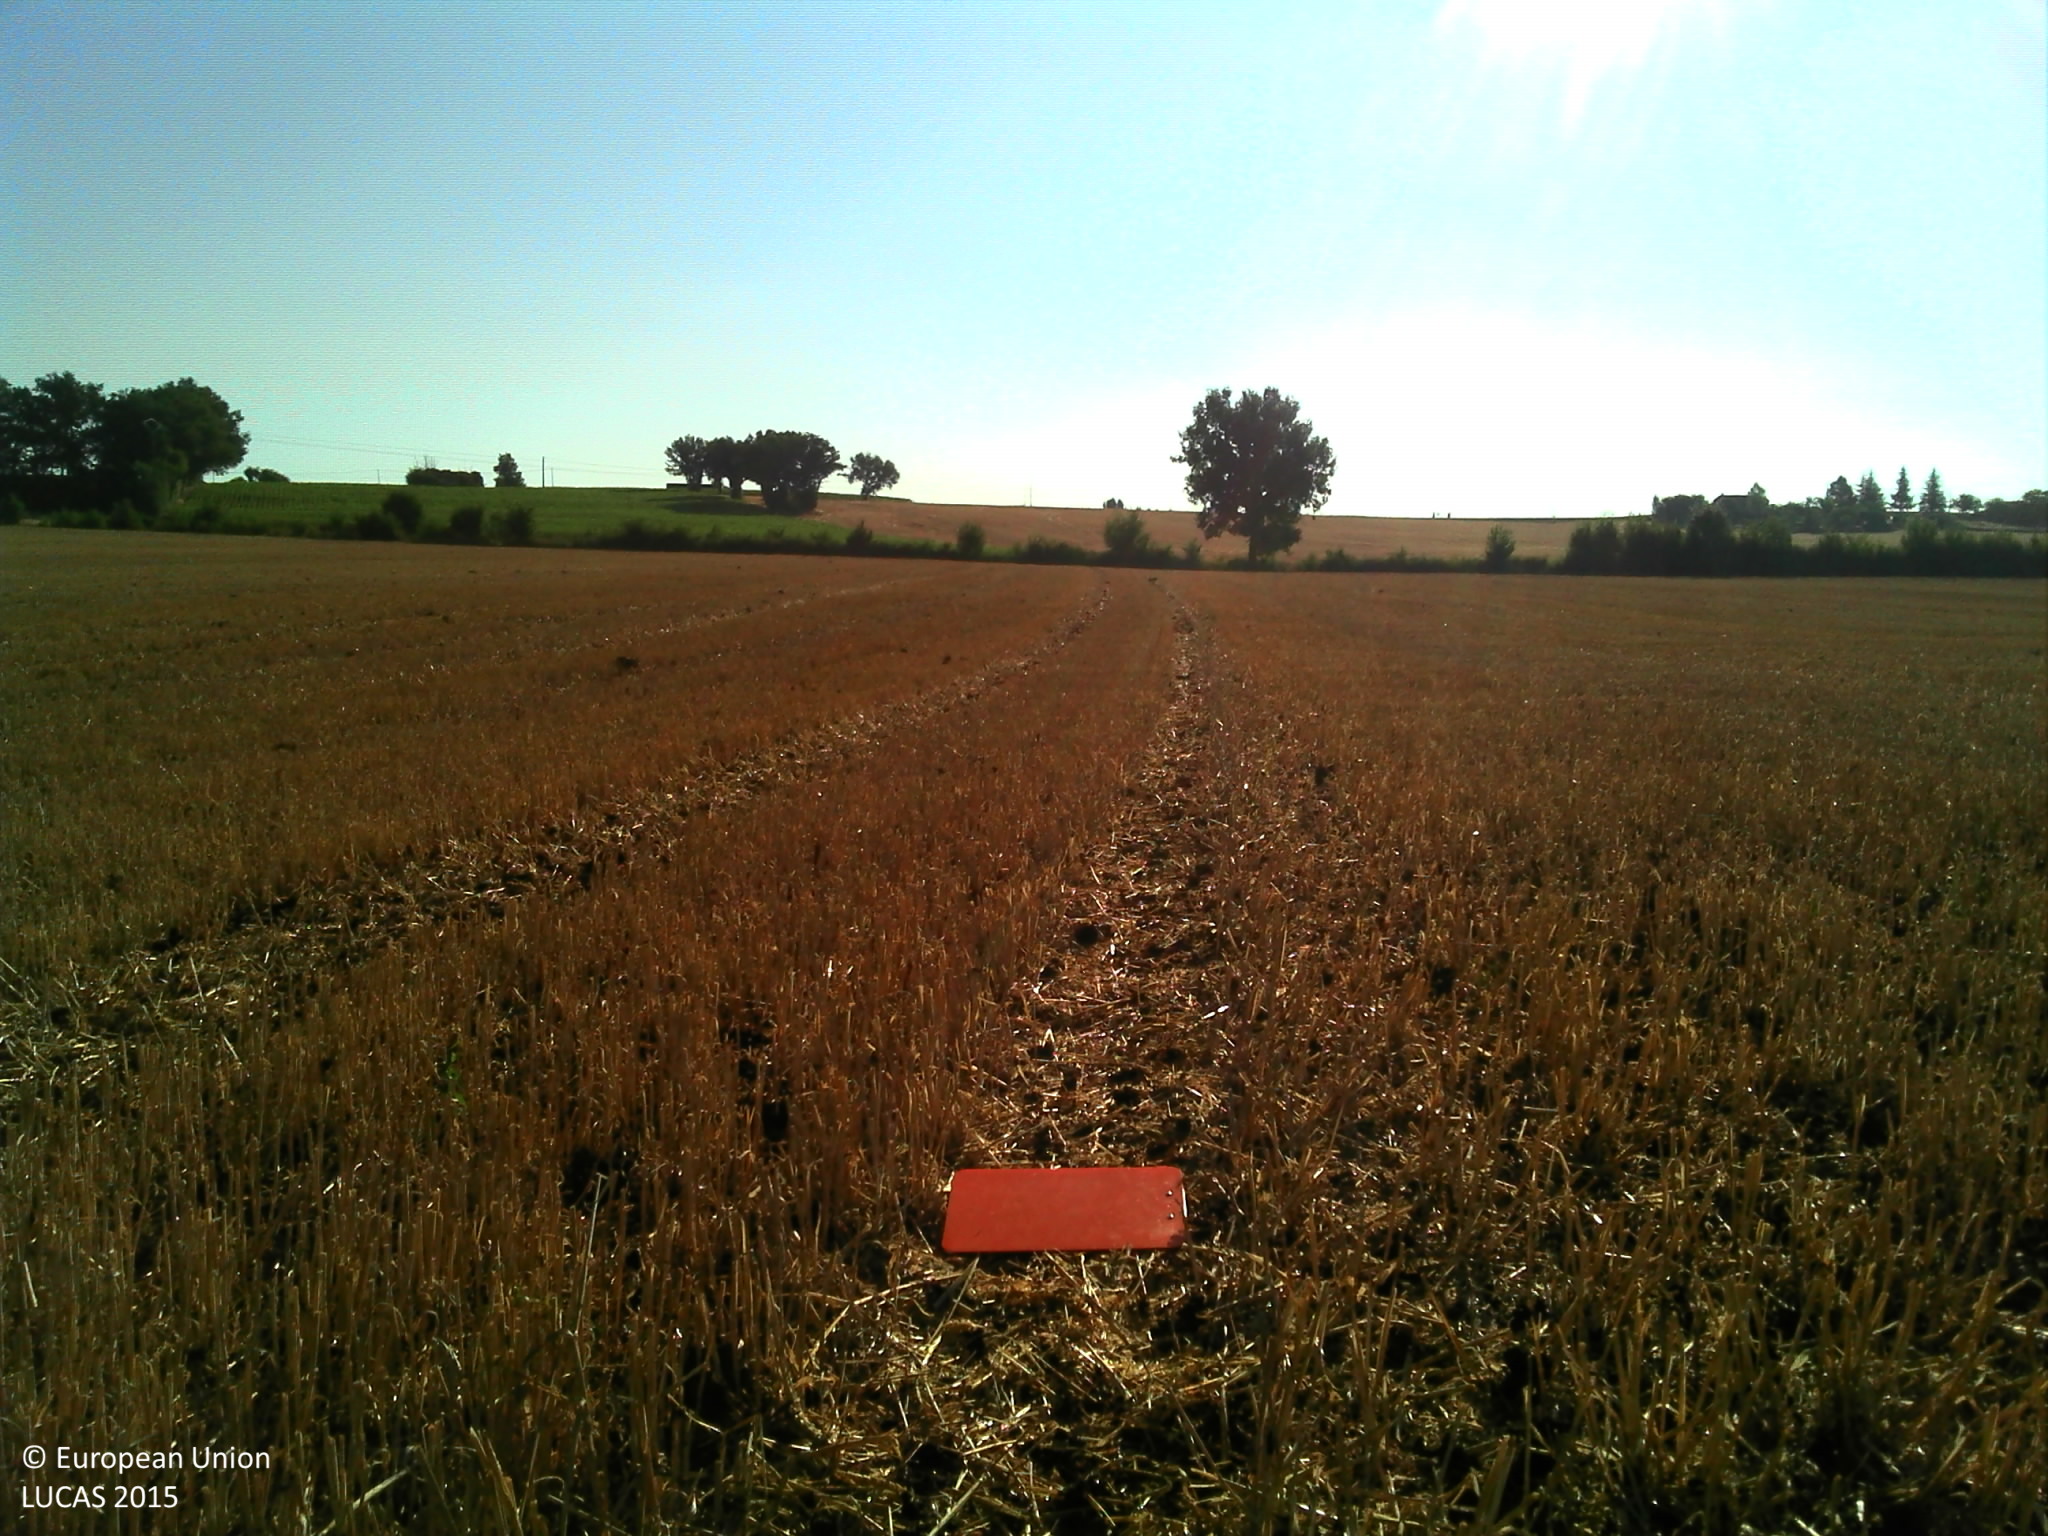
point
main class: Cropland
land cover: Common wheat
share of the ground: > 75 %
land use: Agriculture (excluding fallow land and kitchen gardens)
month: July
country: FR
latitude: 44.5951
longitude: 0.6073
